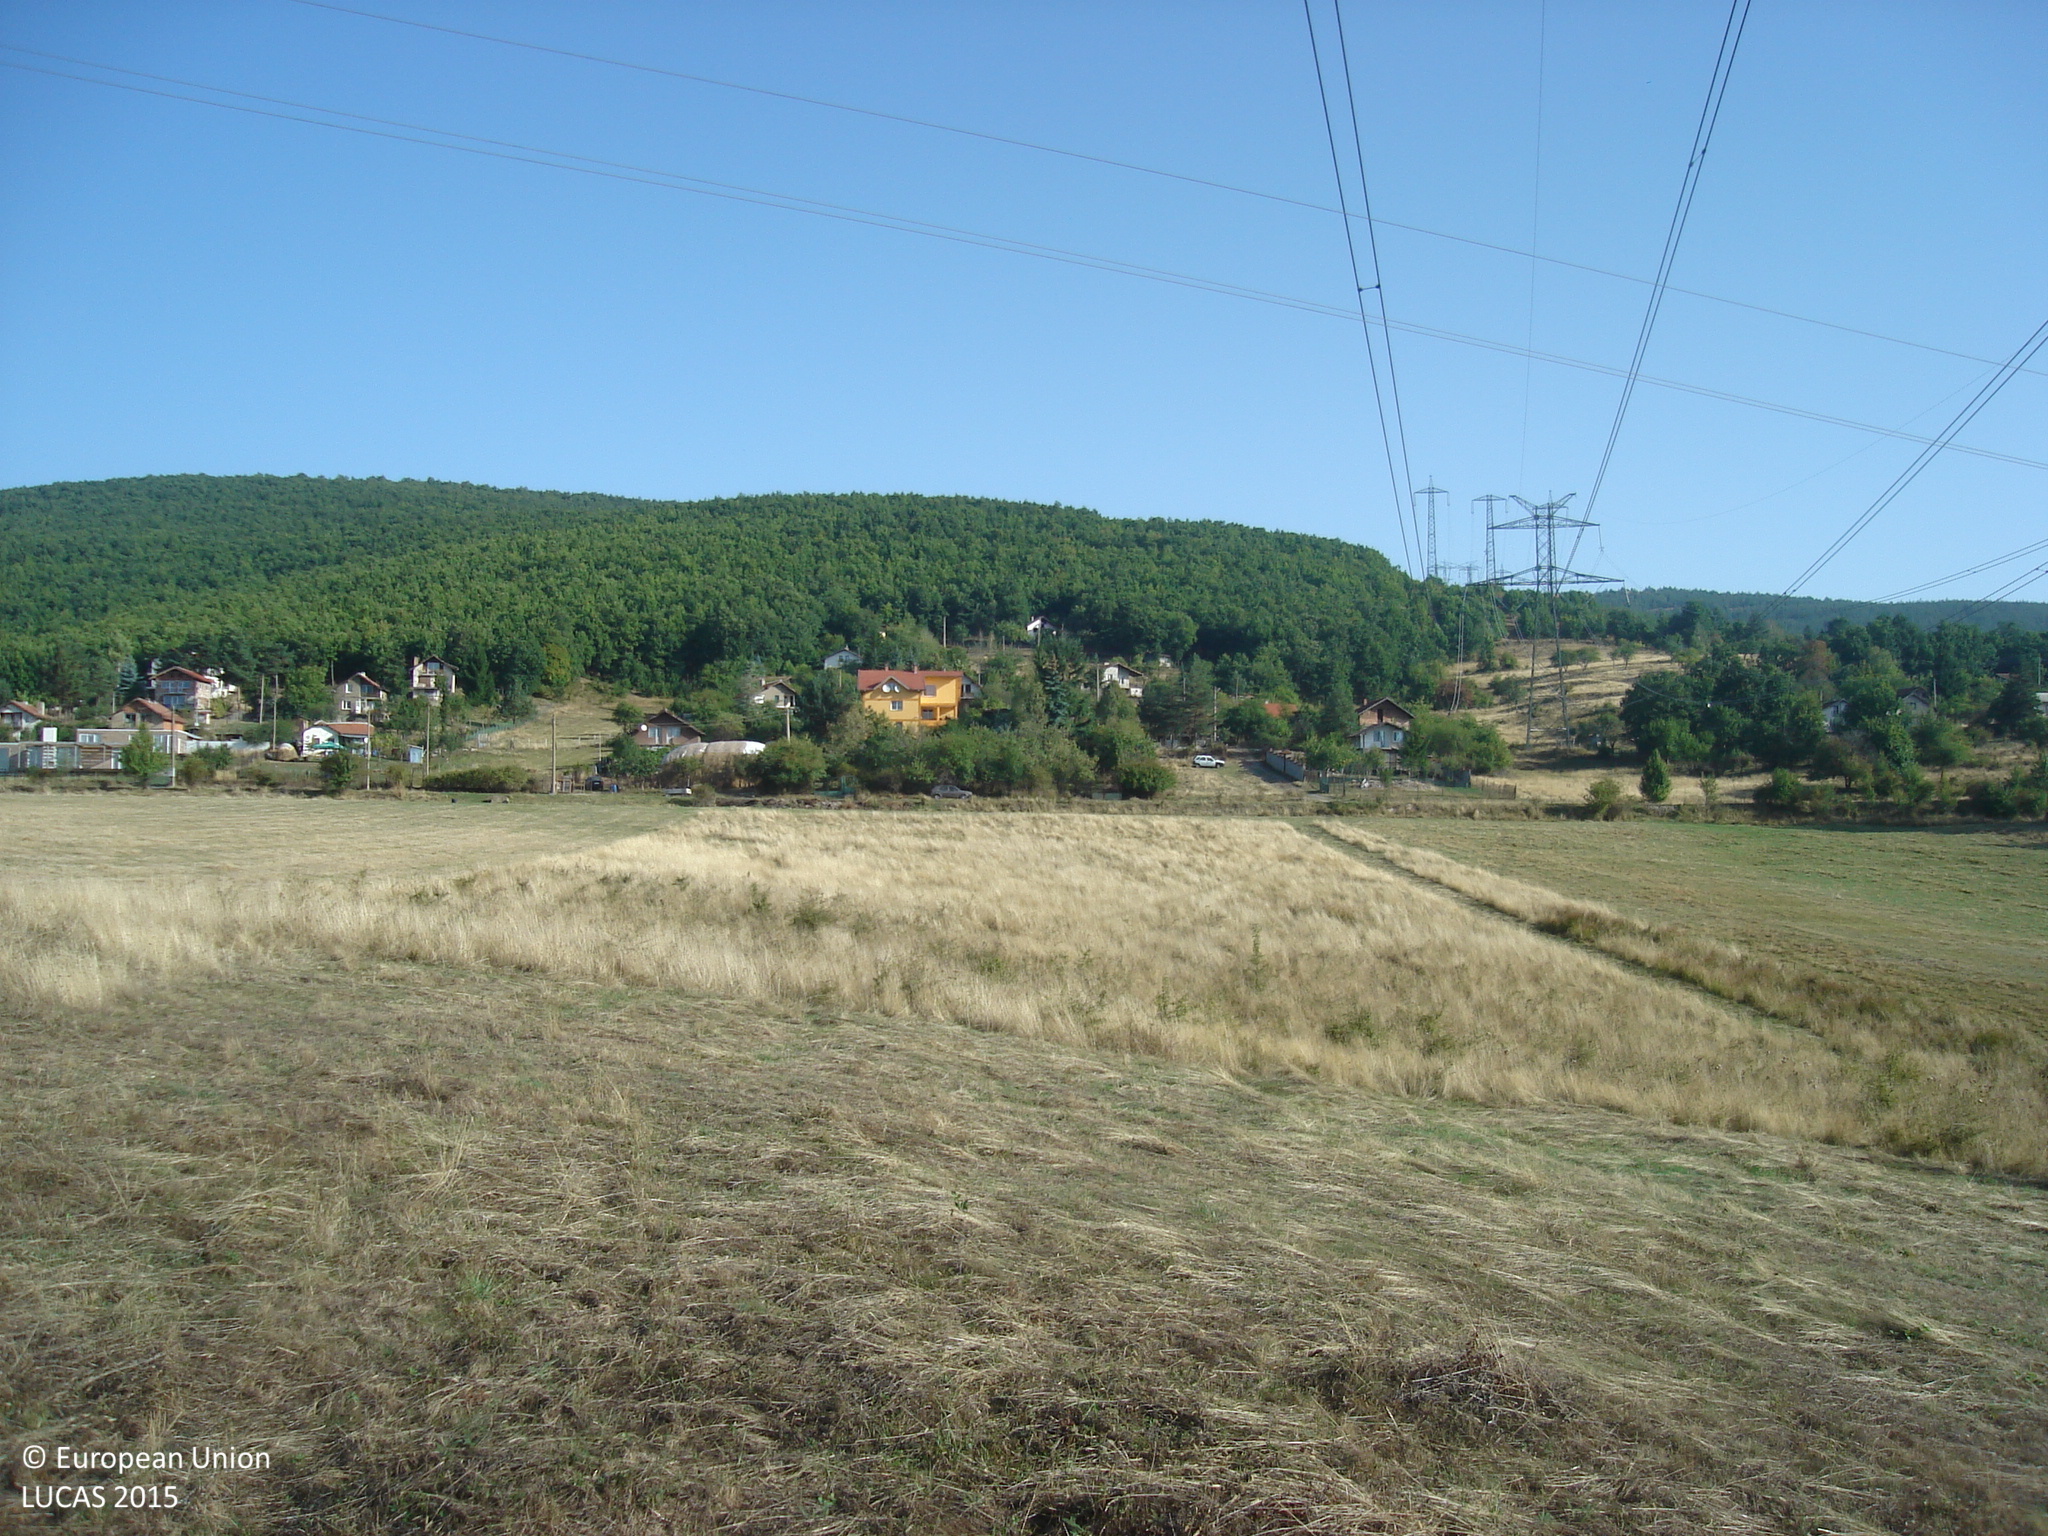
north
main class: Grassland
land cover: Grassland without tree/shrub cover
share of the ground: > 75 %
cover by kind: herbaceous plants 100 %
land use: Agriculture (excluding fallow land and kitchen gardens)
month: September
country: BG
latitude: 42.9328
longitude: 23.2322
